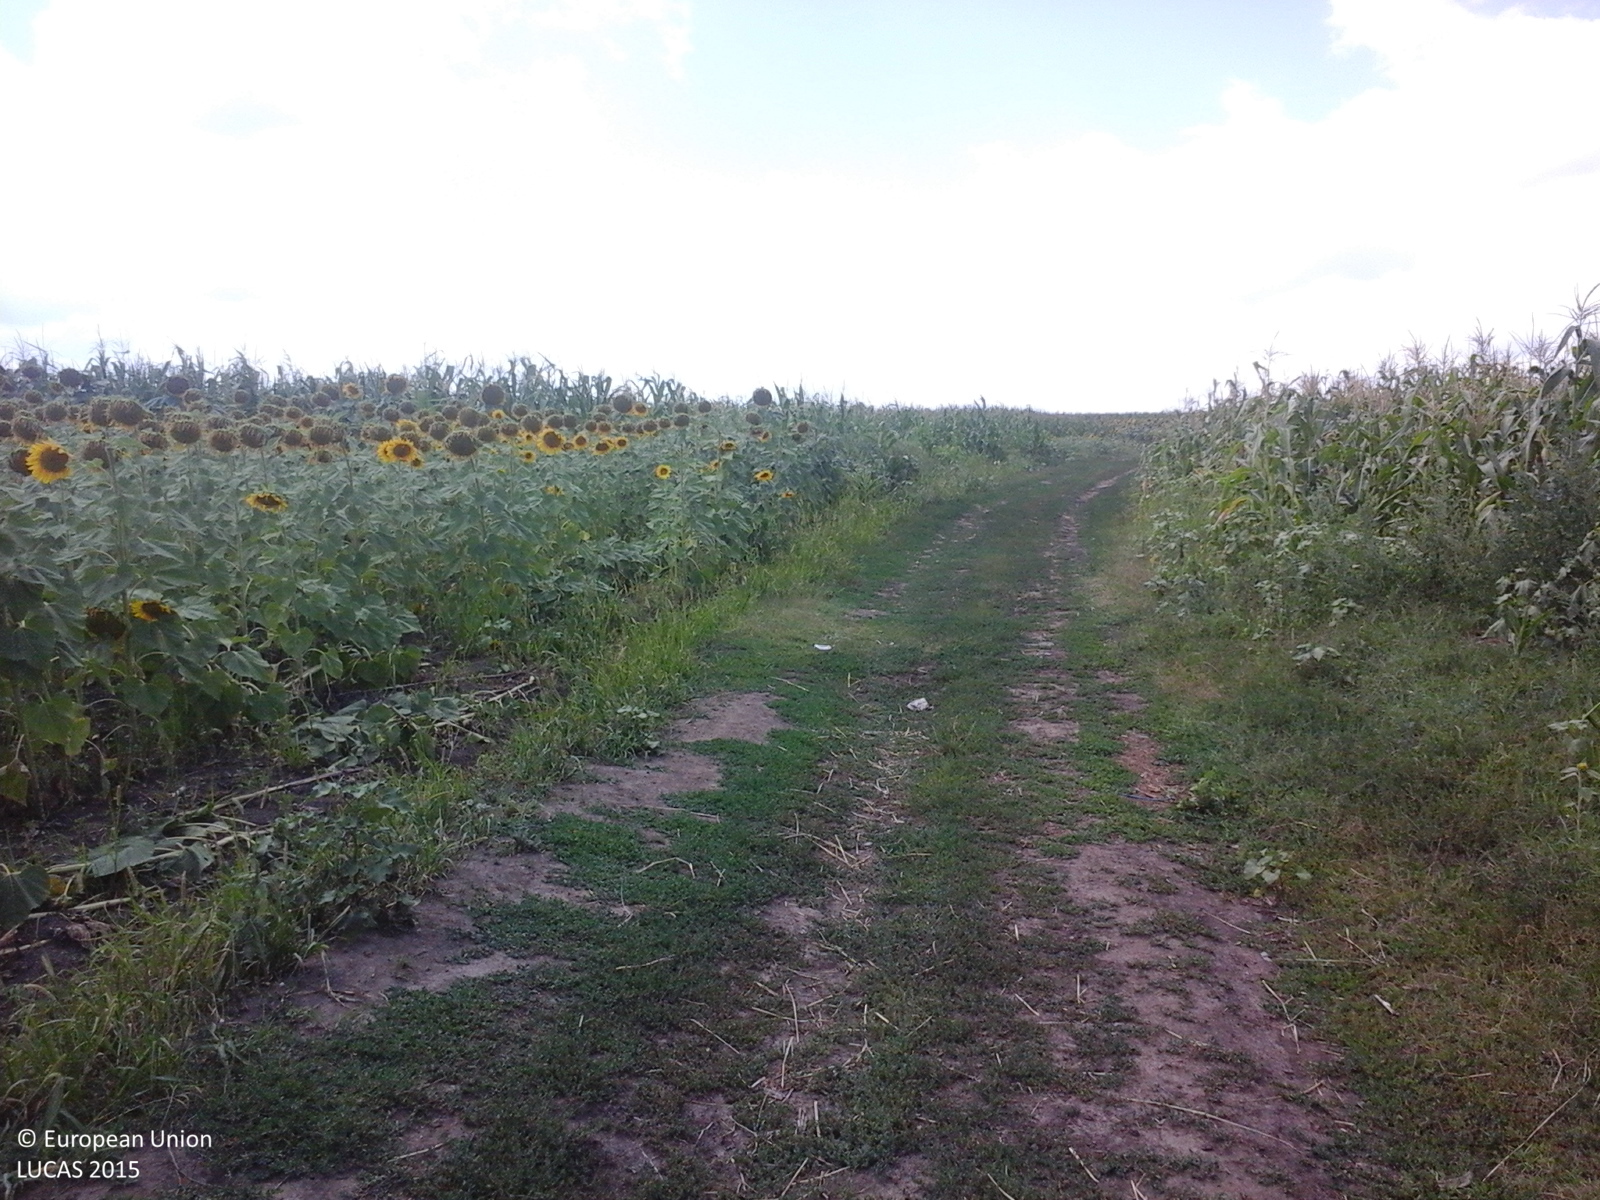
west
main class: Cropland
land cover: Maize
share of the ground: > 75 %
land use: Agriculture (excluding fallow land and kitchen gardens)
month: July
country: RO
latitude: 46.4486
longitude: 27.8921
